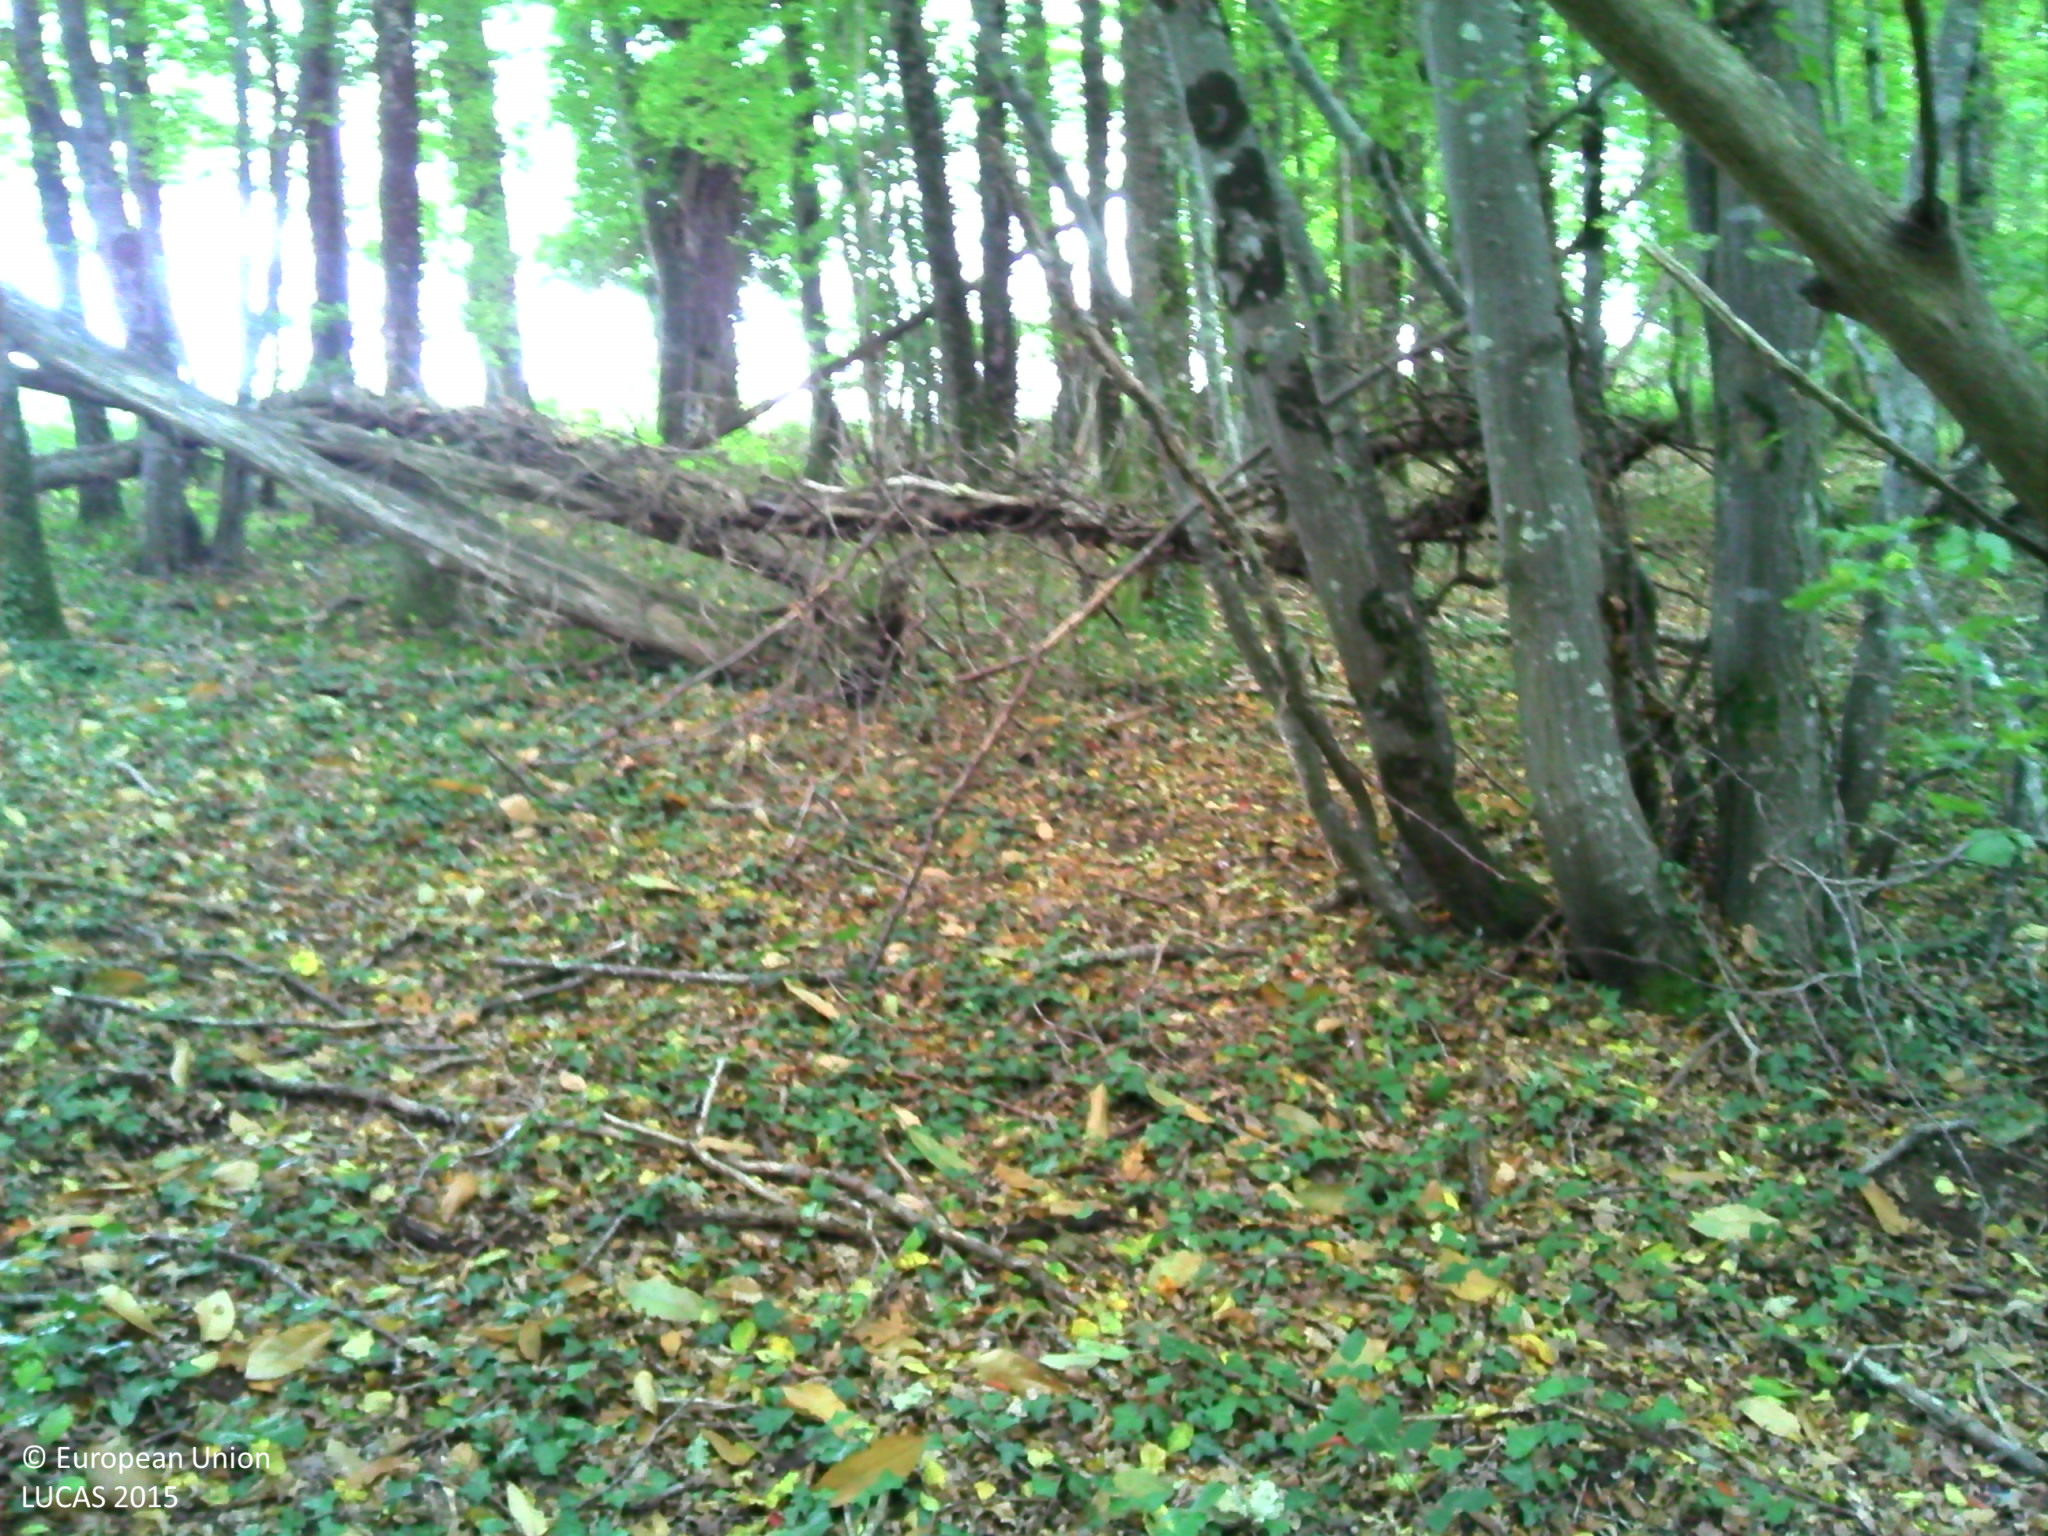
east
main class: Woodland
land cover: Broadleaved woodland
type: mesophytic deciduous forest
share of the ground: > 75 %
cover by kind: broadleaved forest trees 85 %, unconsolidated bare surface 10 %, herbaceous plants 5 %
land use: Forestry
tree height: > 5 m
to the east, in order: Broadleaved woodland; Fences; Grassland without tree/shrub cover; Abandoned hedges; Grassland without tree/shrub cover; Fences; Grassland without tree/shrub cover; Fences; Grassland without tree/shrub cover
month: September
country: FR
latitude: 46.4206
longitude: 1.6245
